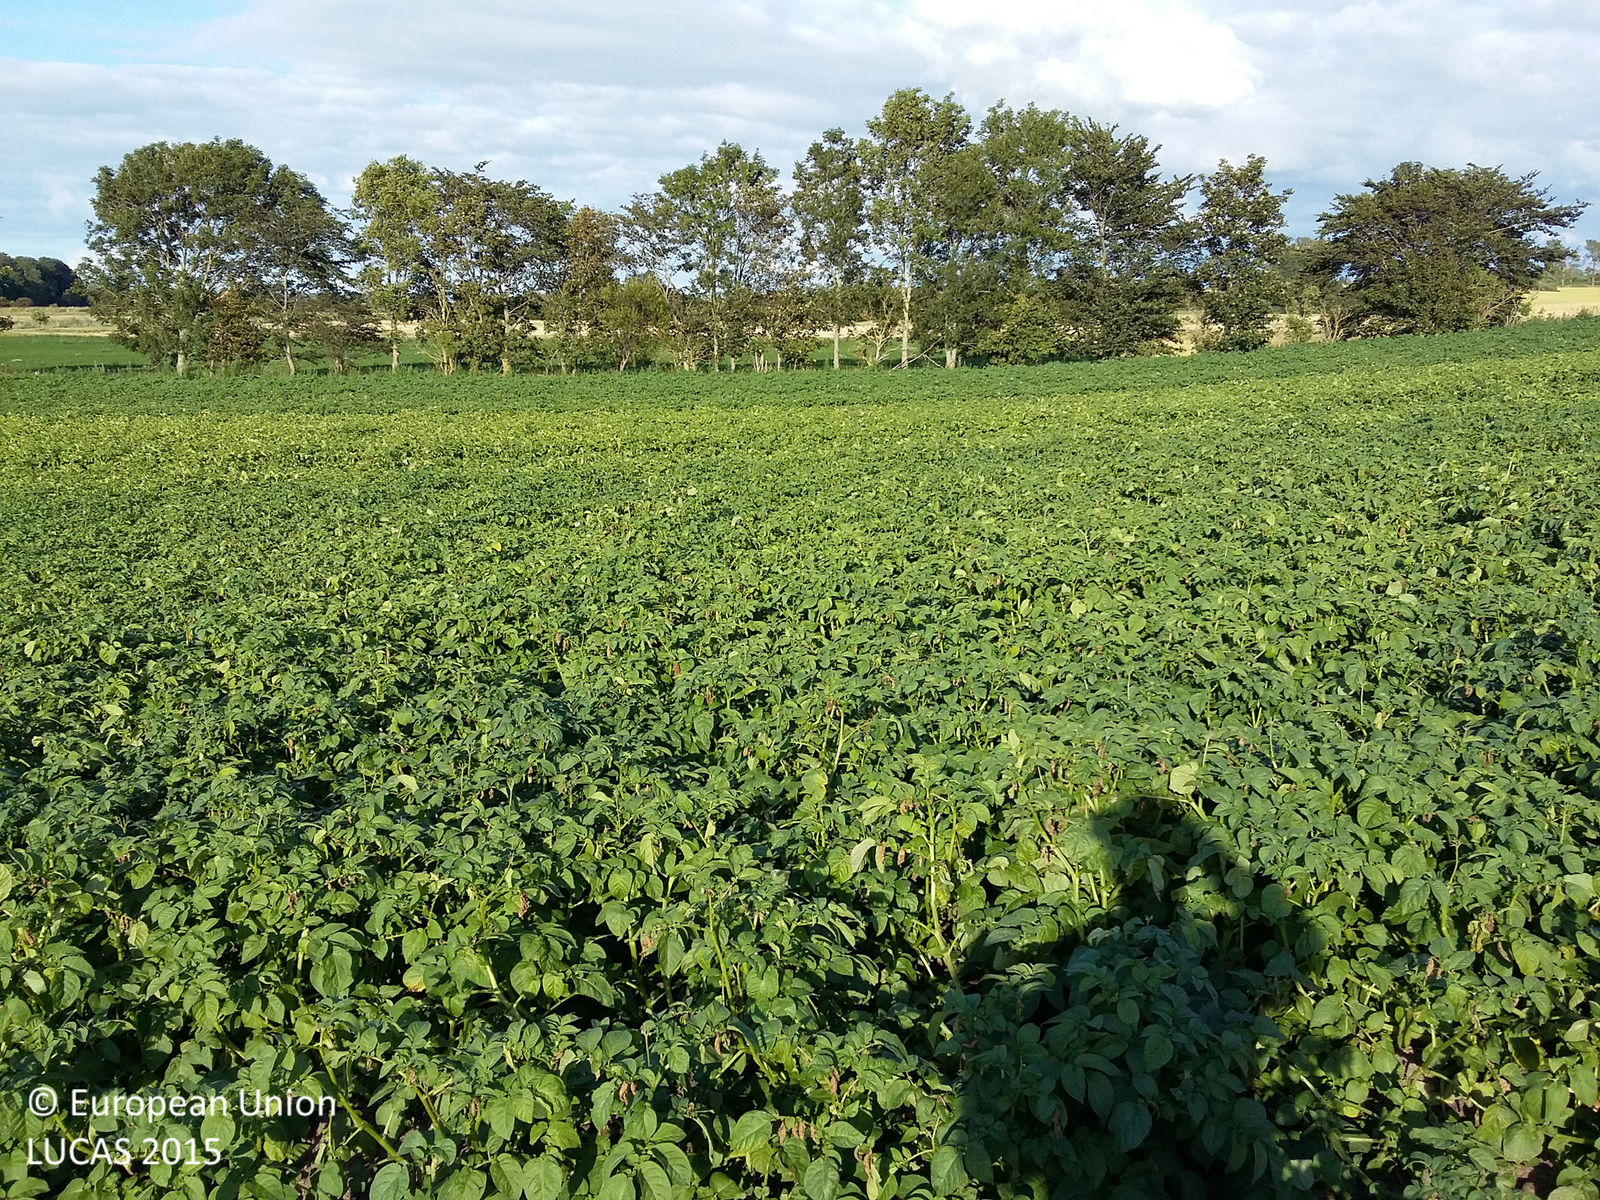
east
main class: Cropland
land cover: Potatoes
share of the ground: > 75 %
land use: Agriculture (excluding fallow land and kitchen gardens)
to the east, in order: Potatoes; Broadleaved woodland; Other root crops; Barley
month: July
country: DK
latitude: 55.7668
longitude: 11.3853
